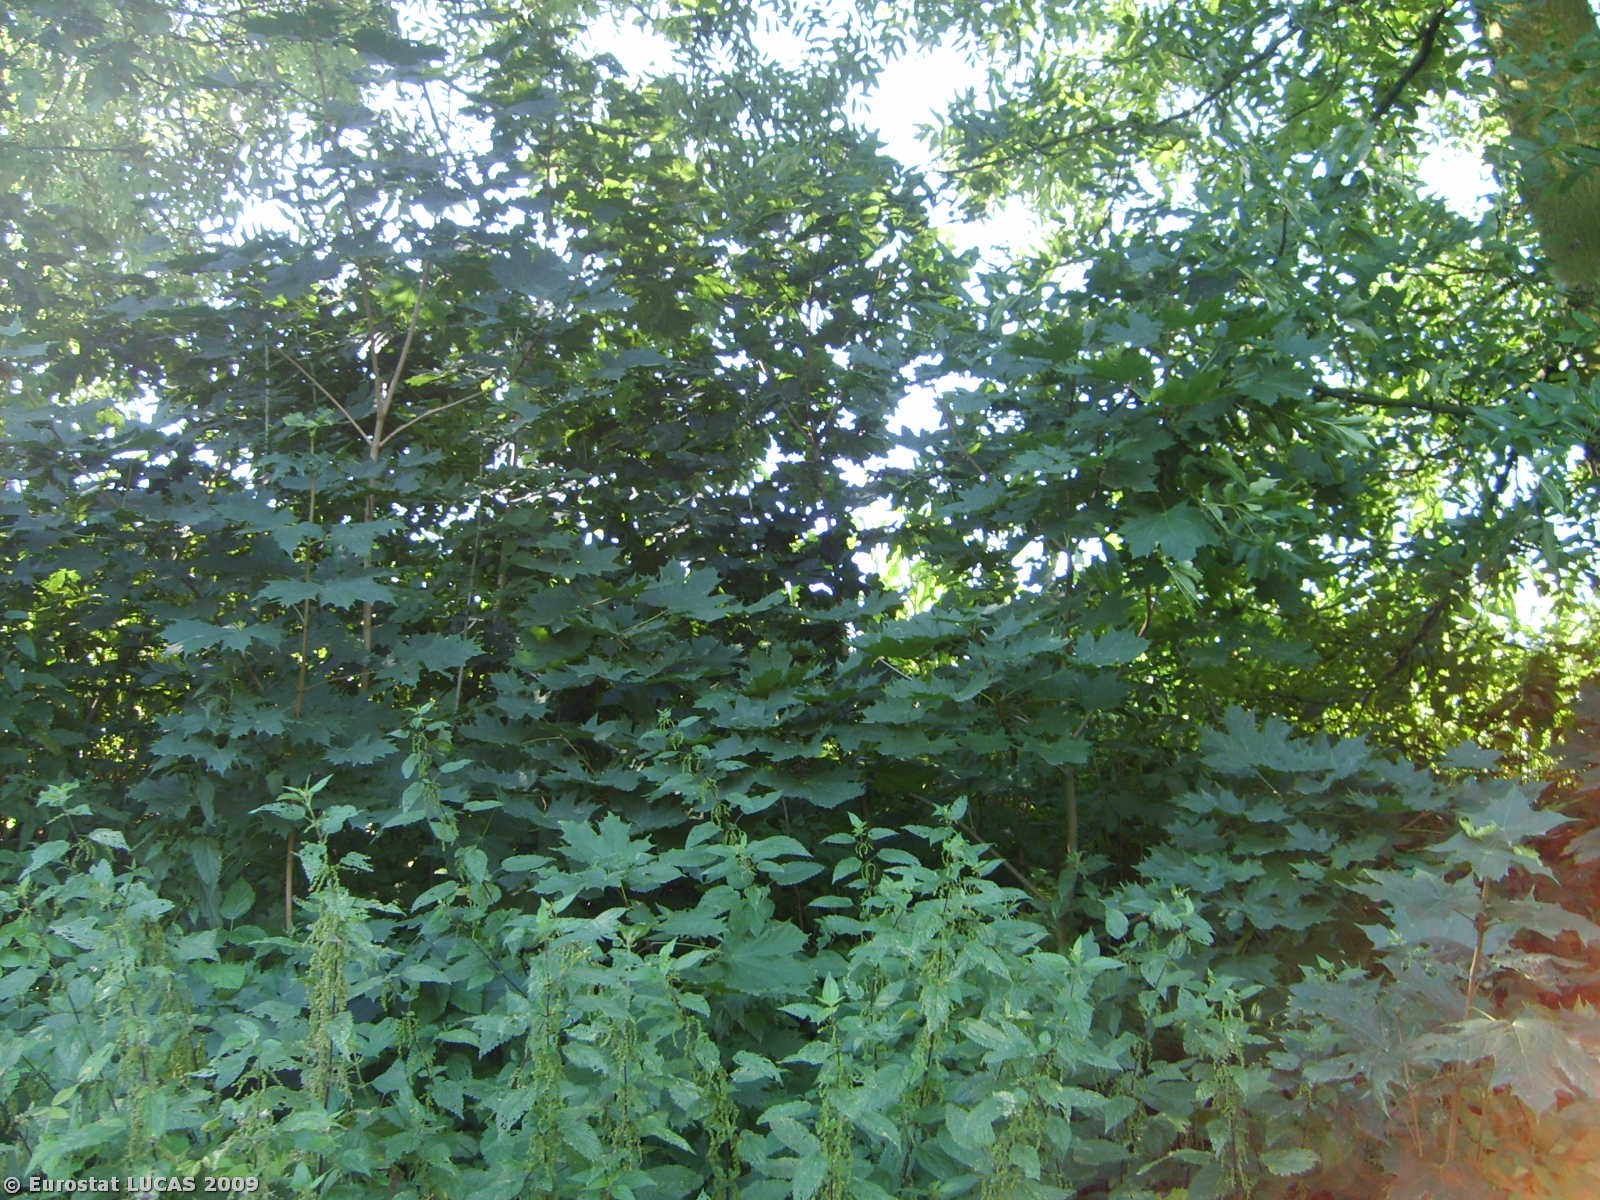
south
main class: Cropland
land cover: Maize
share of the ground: 50 - 75 %
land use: Agriculture (excluding fallow land and kitchen gardens)
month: July
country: PL
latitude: 50.1572
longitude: 20.2386
